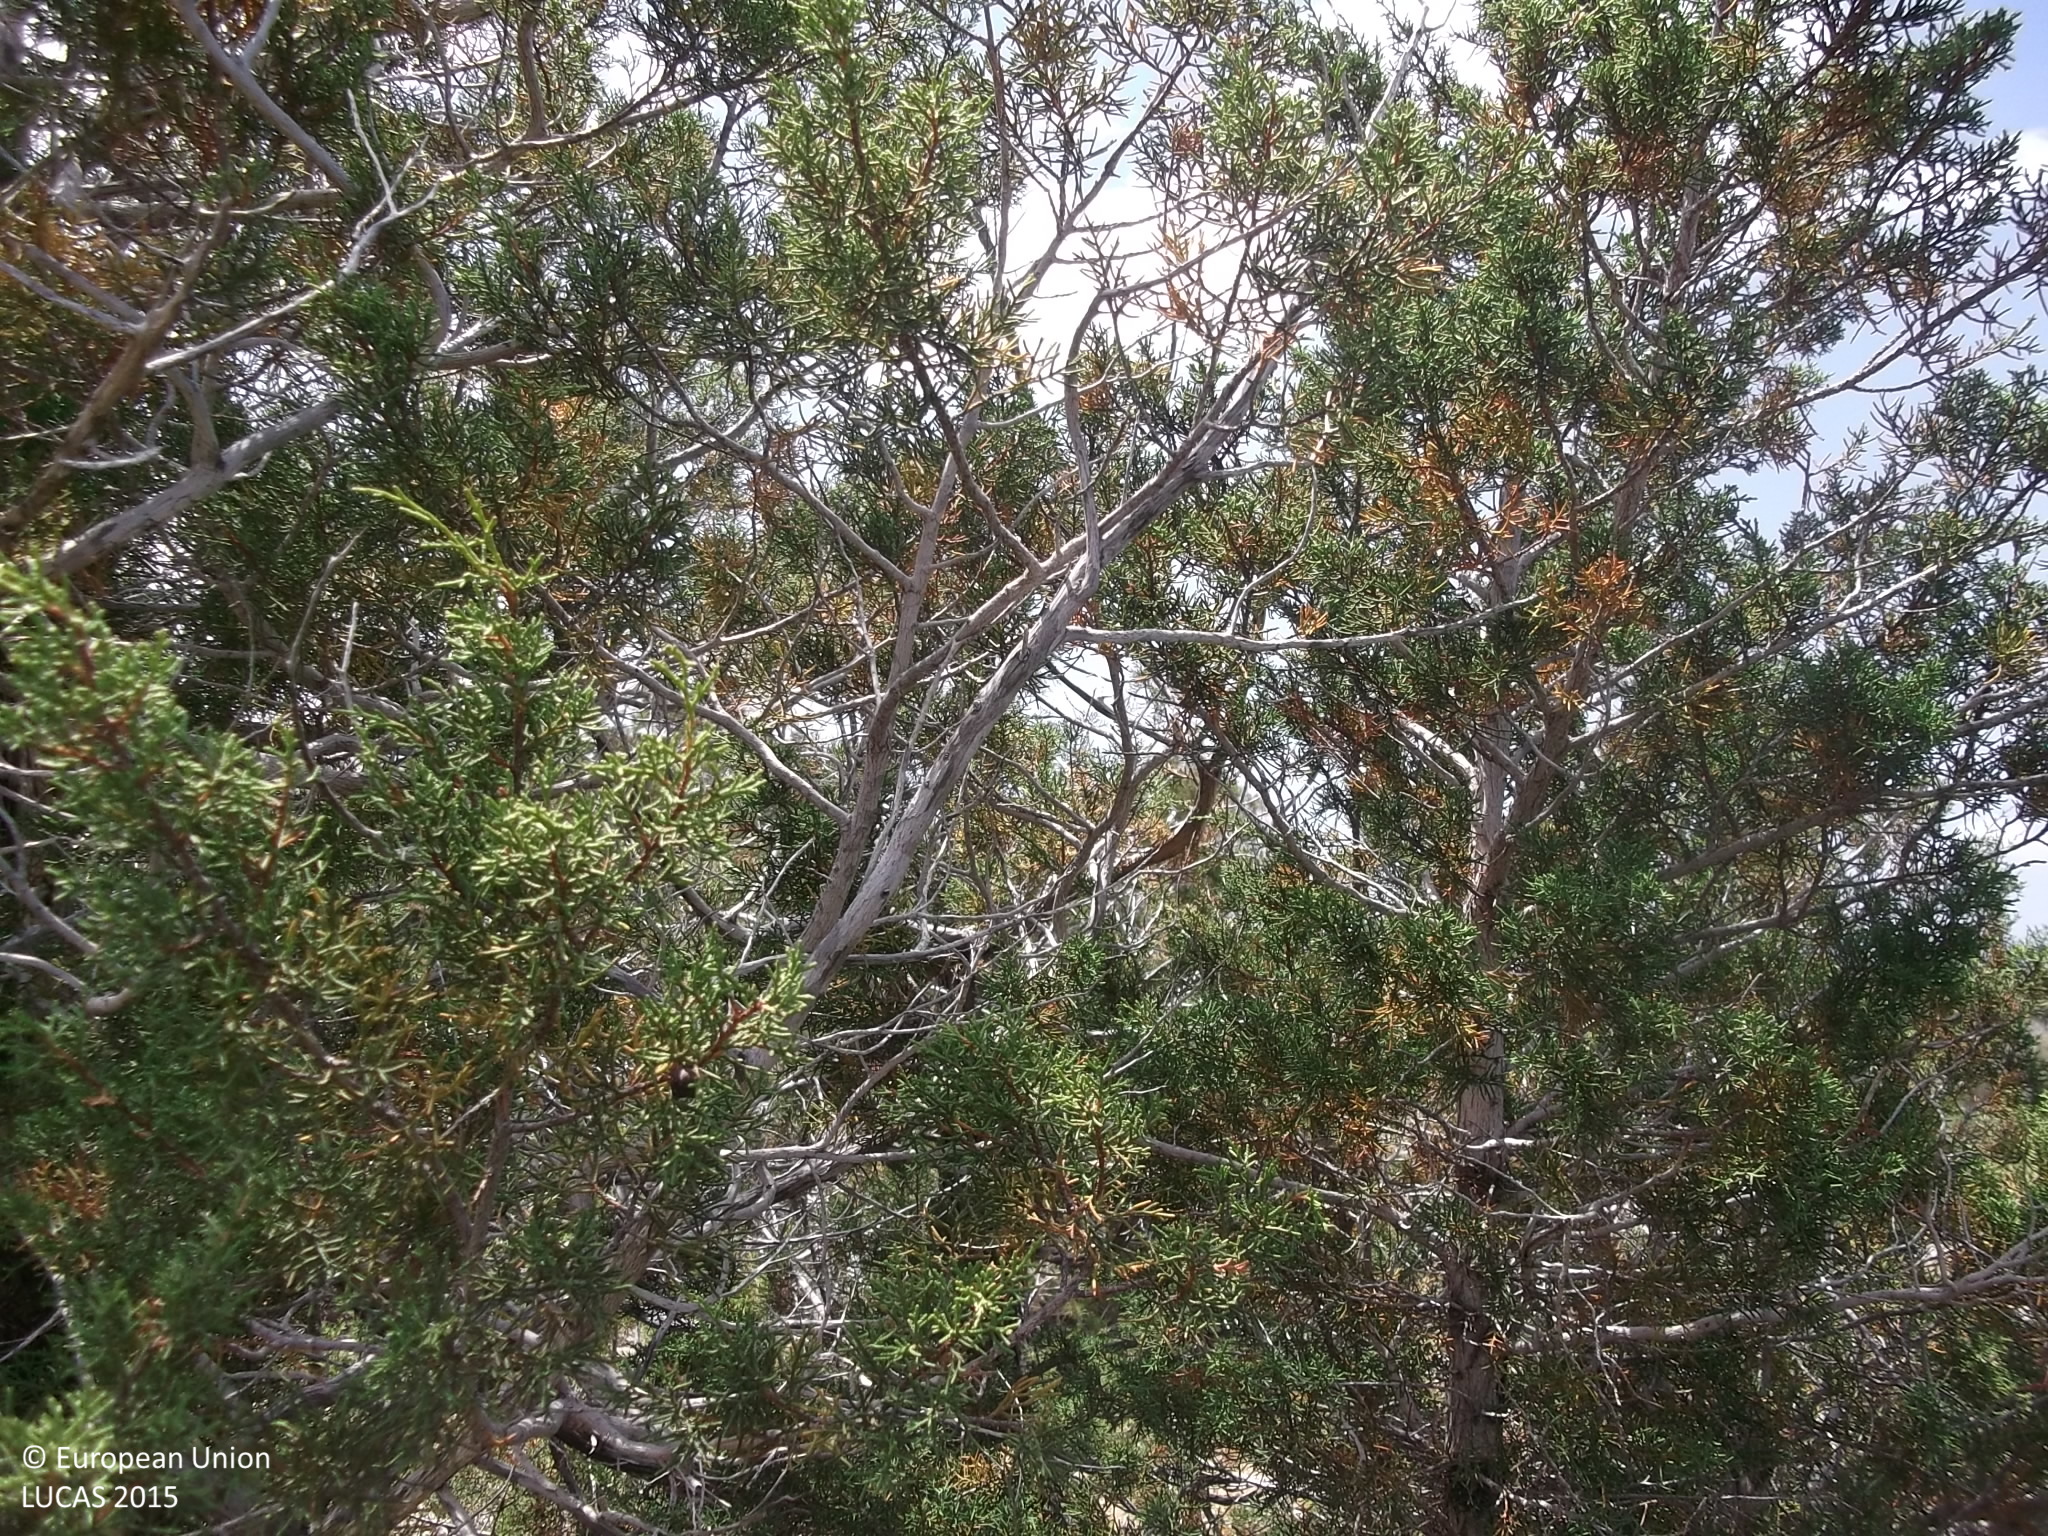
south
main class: Woodland
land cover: Other coniferous woodland
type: coniferous forest of the mediterranean region
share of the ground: > 75 %
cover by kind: coniferous forest trees 100 %
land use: Forestry
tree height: > 5 m
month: May
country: CY
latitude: 35.0490
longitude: 32.2835
